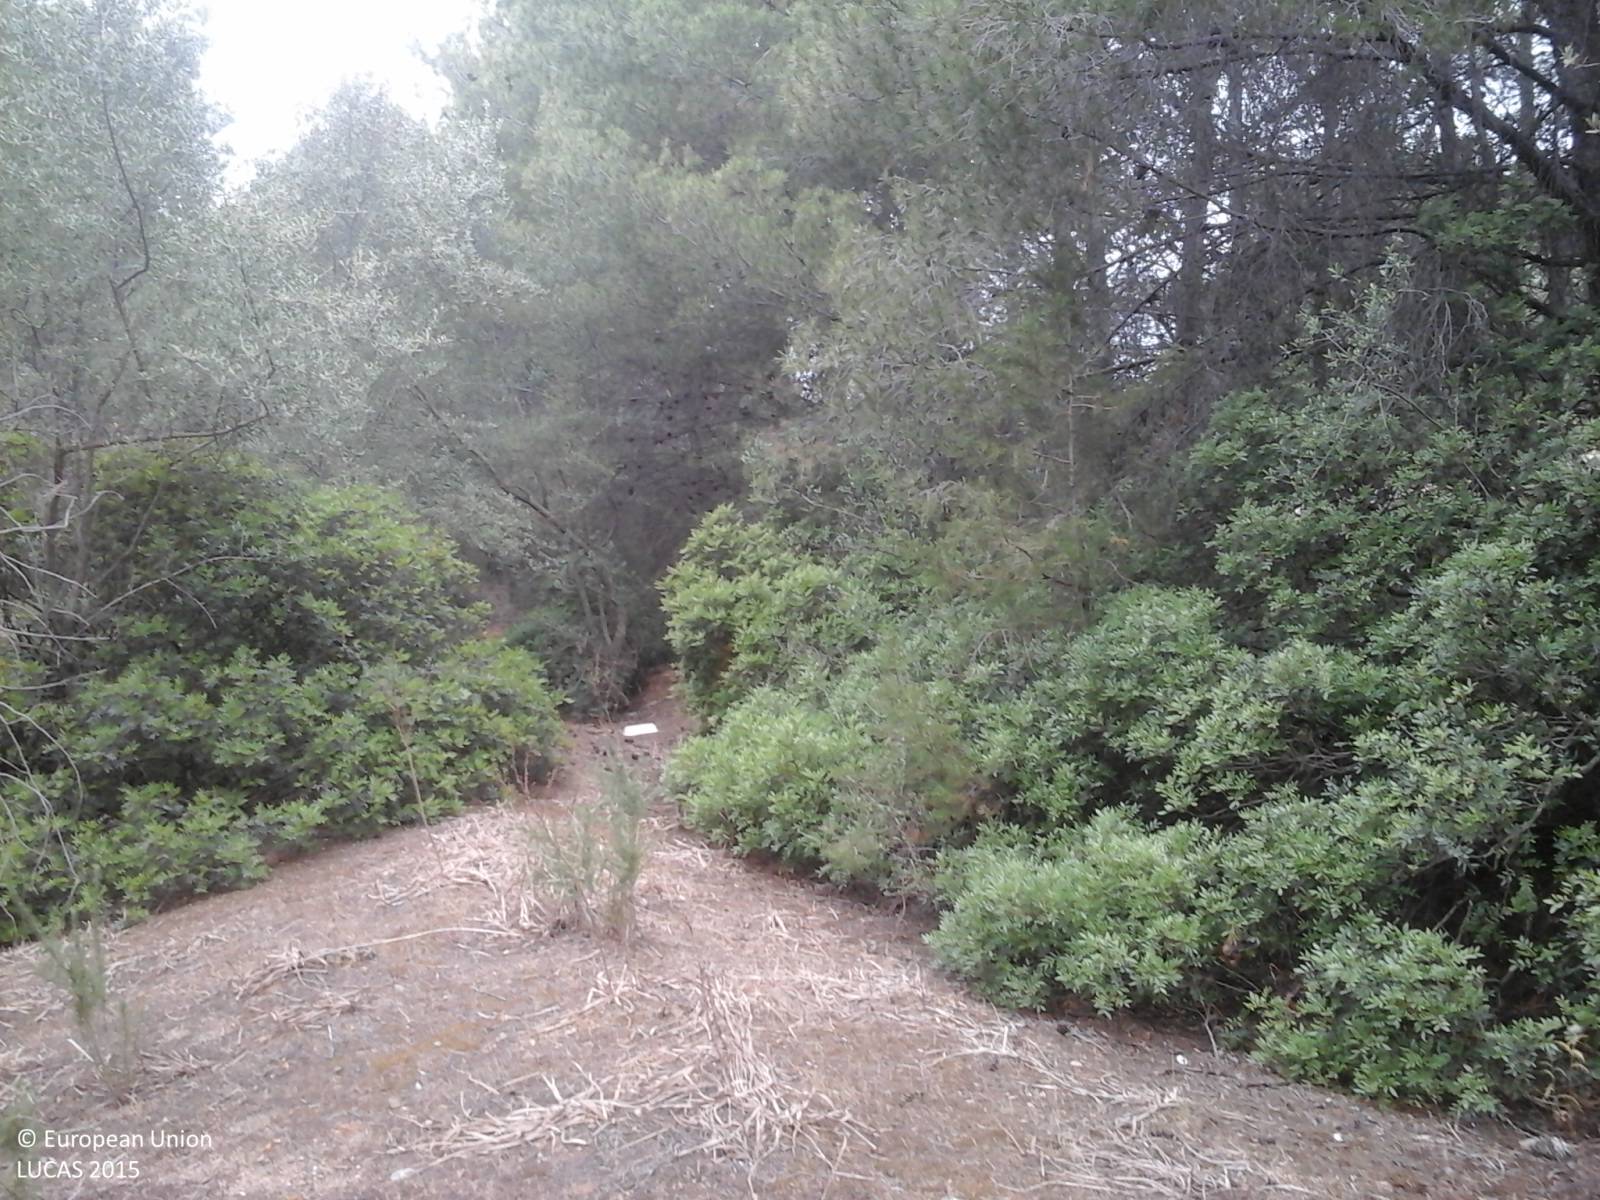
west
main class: Woodland
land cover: Pine dominated coniferous woodland
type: coniferous forest of the mediterranean region
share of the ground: > 75 %
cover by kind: coniferous forest trees 50 %, shrubs 30 %, broadleaved forest trees 10 %, herbaceous plants 10 %
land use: Semi-natural and natural areas not in use
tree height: > 5 m
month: May
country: IT
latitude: 39.1965
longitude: 9.3441
